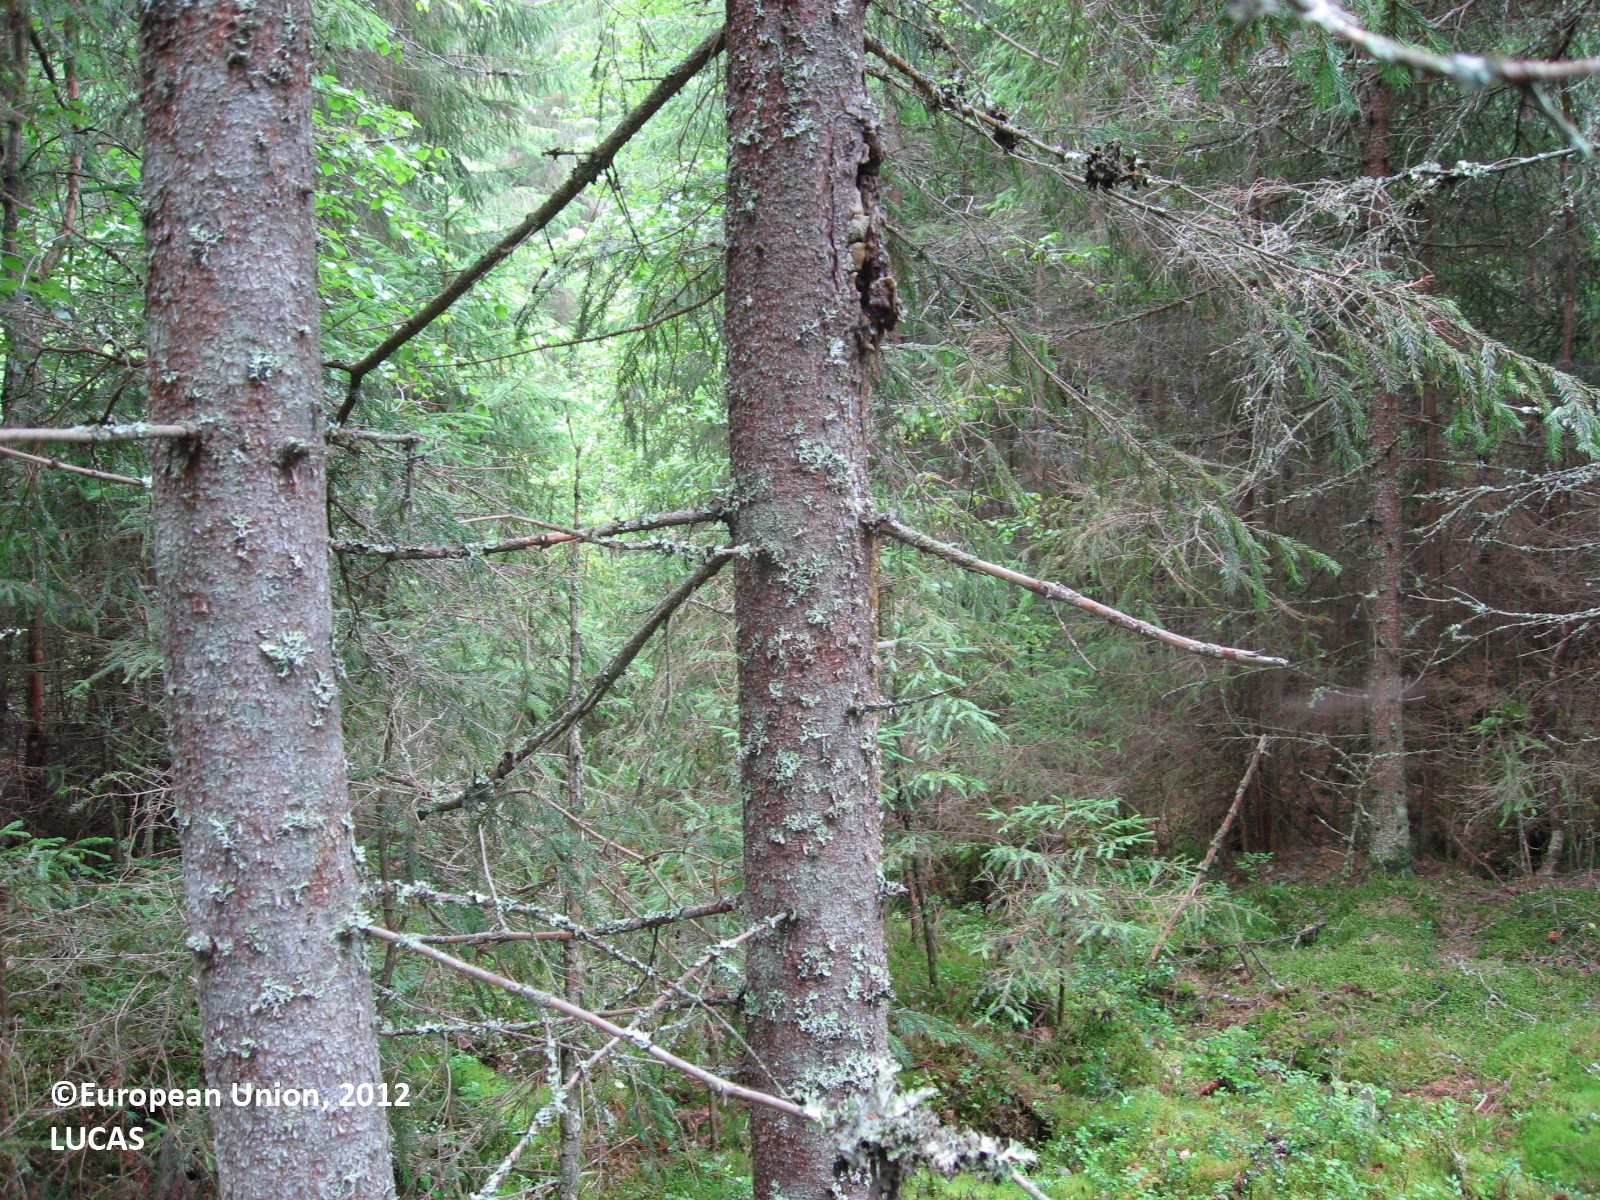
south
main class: Woodland
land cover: Spruce dominated mixed woodland
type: boreal forest
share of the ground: 50 - 75 %
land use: Forestry
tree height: > 5 m
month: July
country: FI
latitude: 61.3575
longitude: 25.8592
